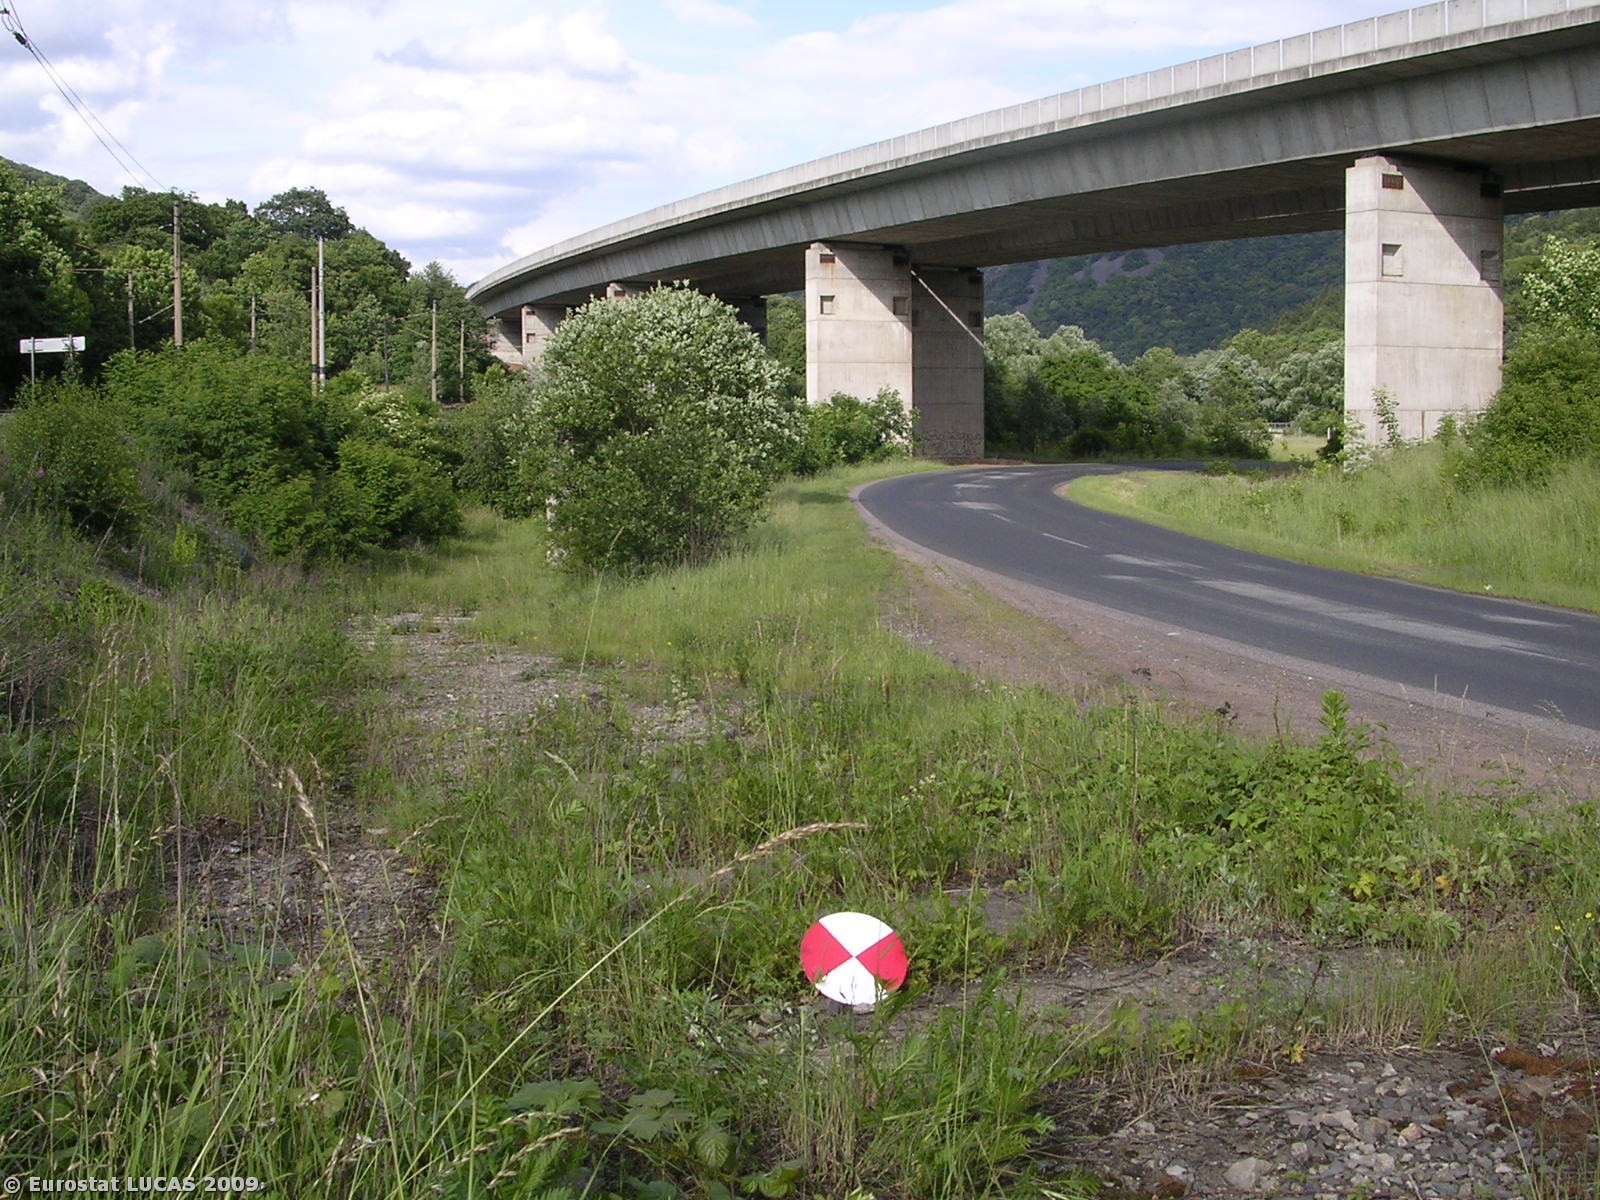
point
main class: Grassland
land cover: Spontaneously vegetated surfaces
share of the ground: 50 - 75 %
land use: Unused
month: June
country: CZ
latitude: 50.6191
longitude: 13.9726
